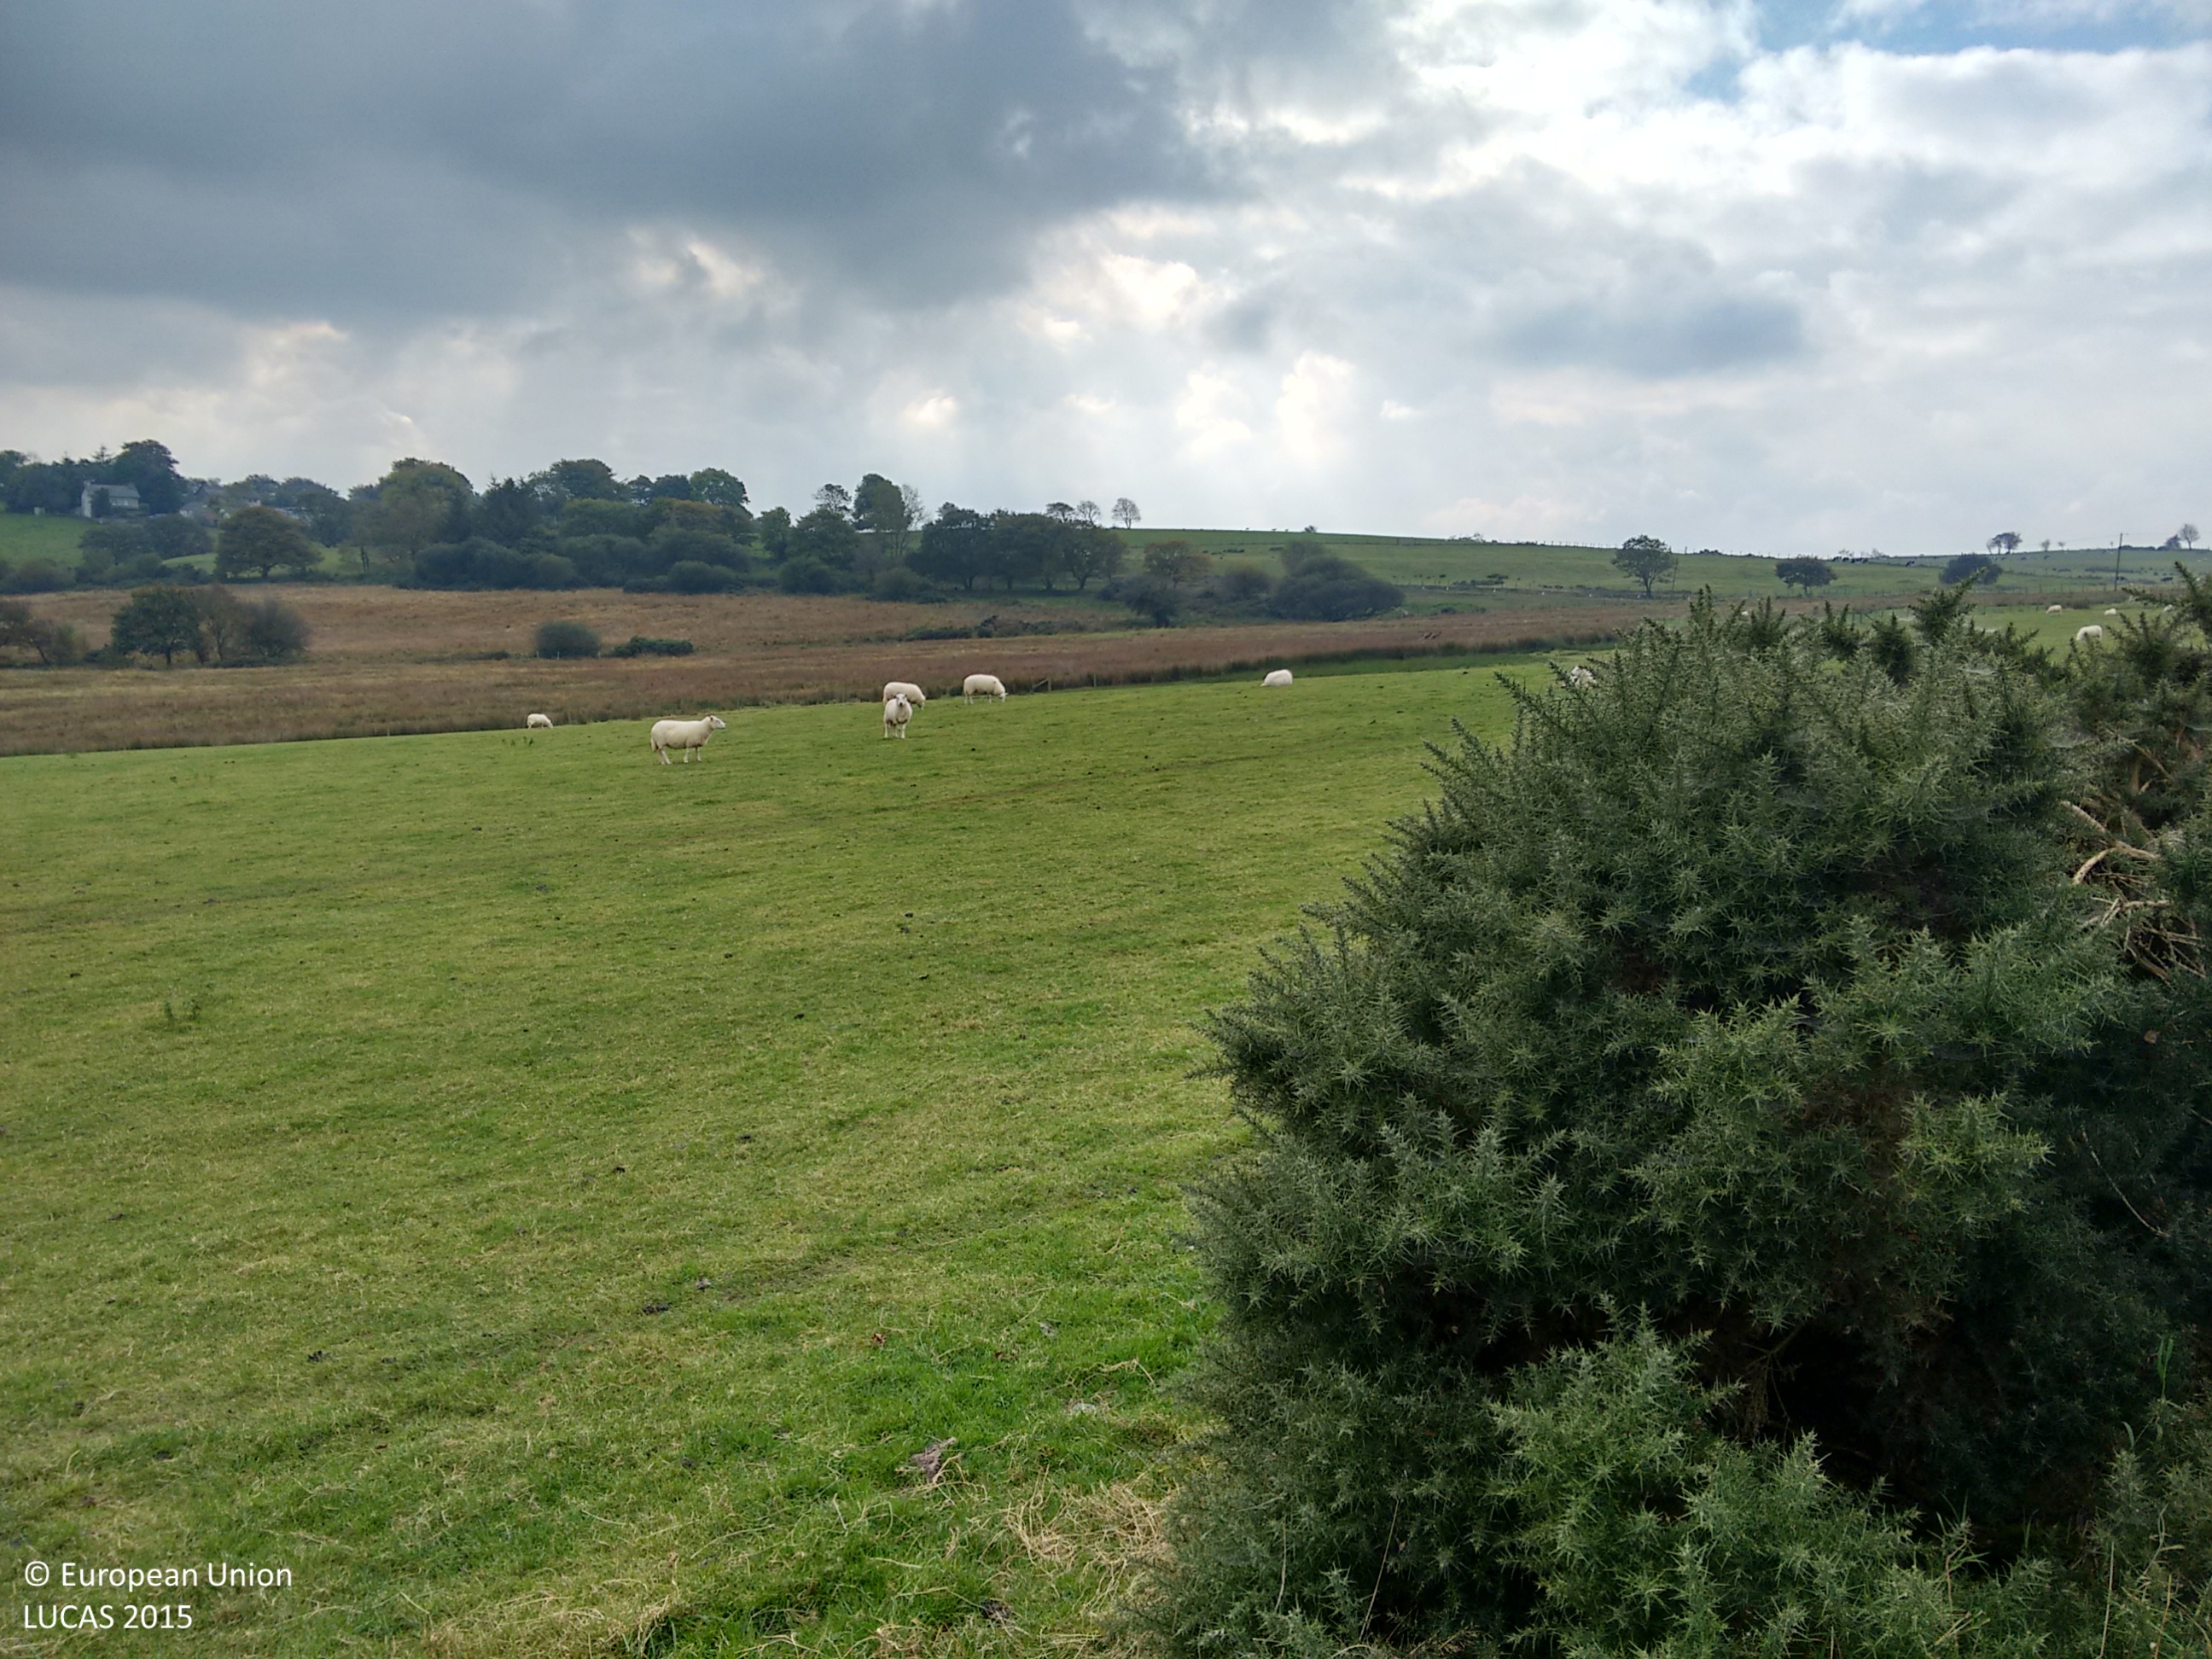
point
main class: Grassland
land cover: Grassland without tree/shrub cover
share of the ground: > 75 %
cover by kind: herbaceous plants 100 %
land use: Agriculture (excluding fallow land and kitchen gardens)
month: October
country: GB
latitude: 52.3003
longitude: -3.9214
